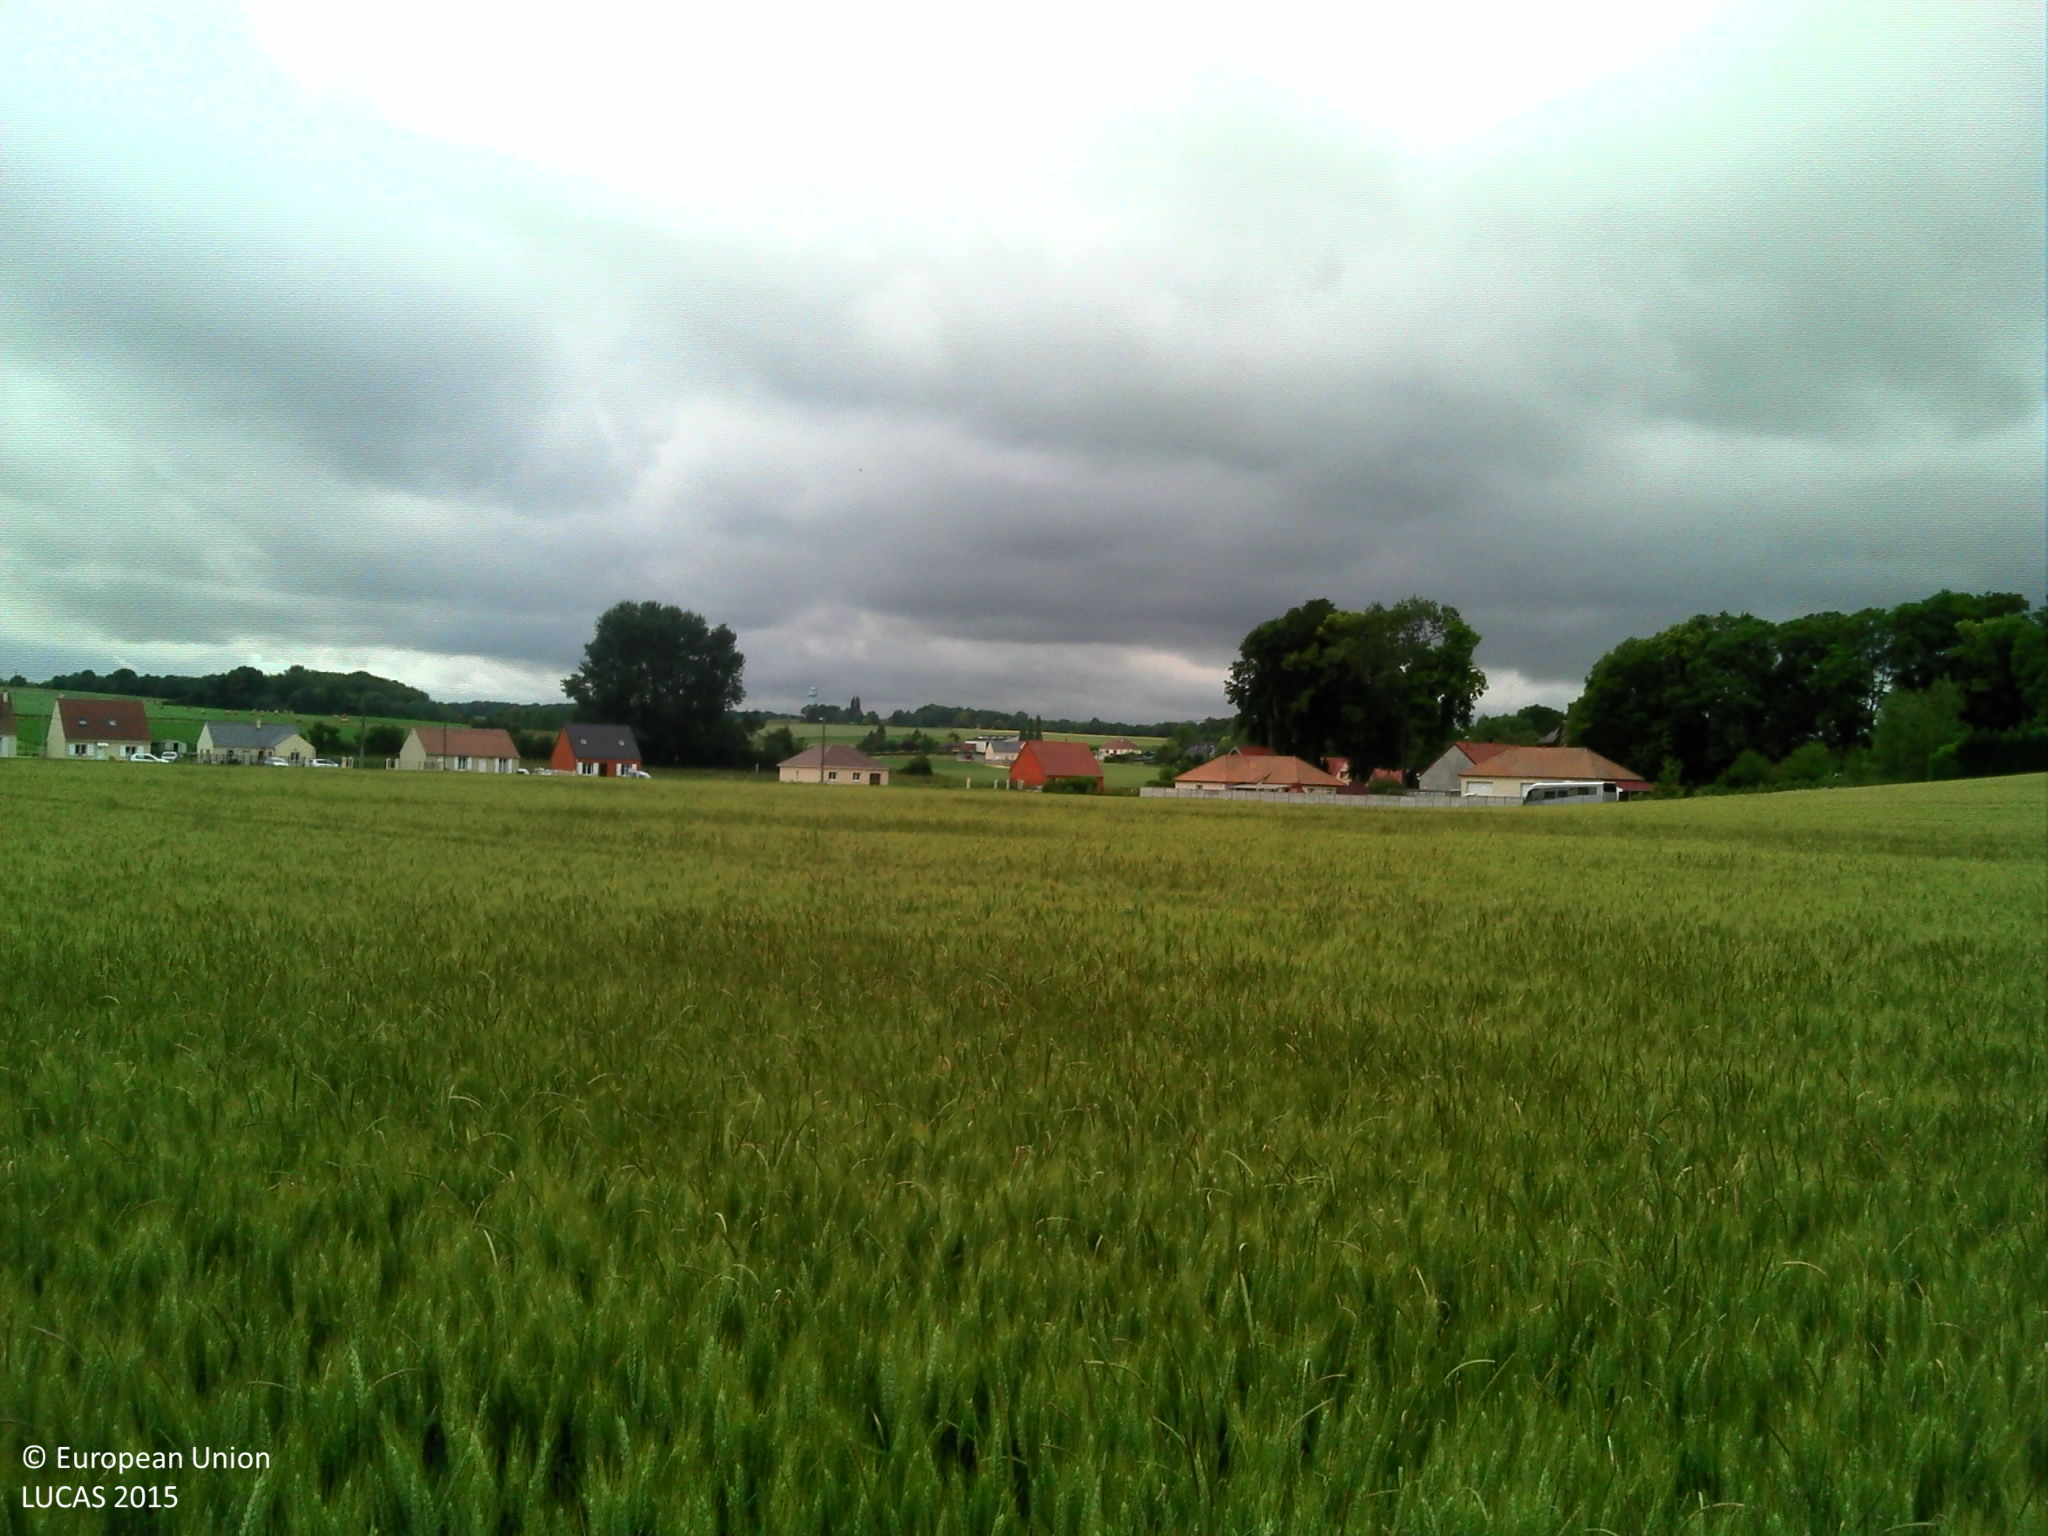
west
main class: Cropland
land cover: Common wheat
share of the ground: > 75 %
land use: Agriculture (excluding fallow land and kitchen gardens)
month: June
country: FR
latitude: 49.6046
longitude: 2.3904
